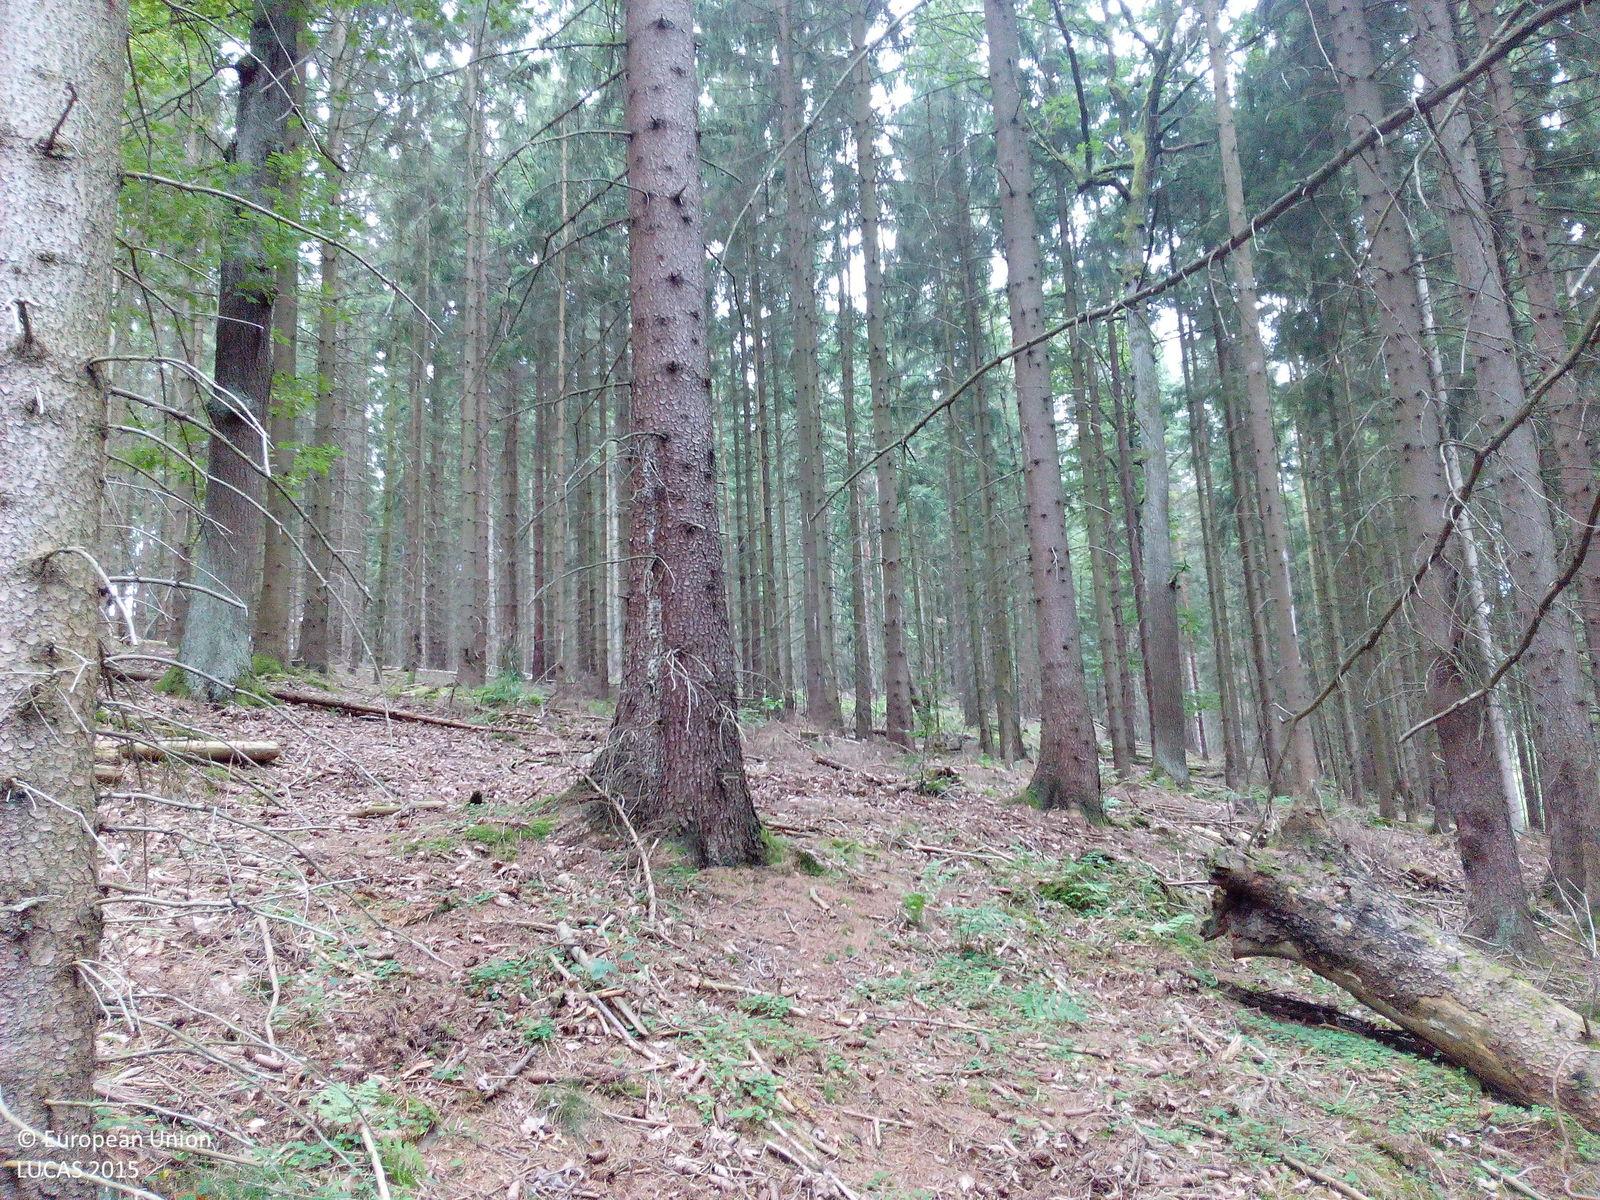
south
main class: Woodland
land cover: Spruce dominated coniferous woodland
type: hemiboreal forest and nemoral coniferous forest and mixed broadleaved-coniferous forest
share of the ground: > 75 %
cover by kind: coniferous forest trees 80 %, herbaceous plants 10 %, lichens and mosses 10 %
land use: Forestry
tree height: > 5 m
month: August
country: DE
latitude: 51.7074
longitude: 11.0850
